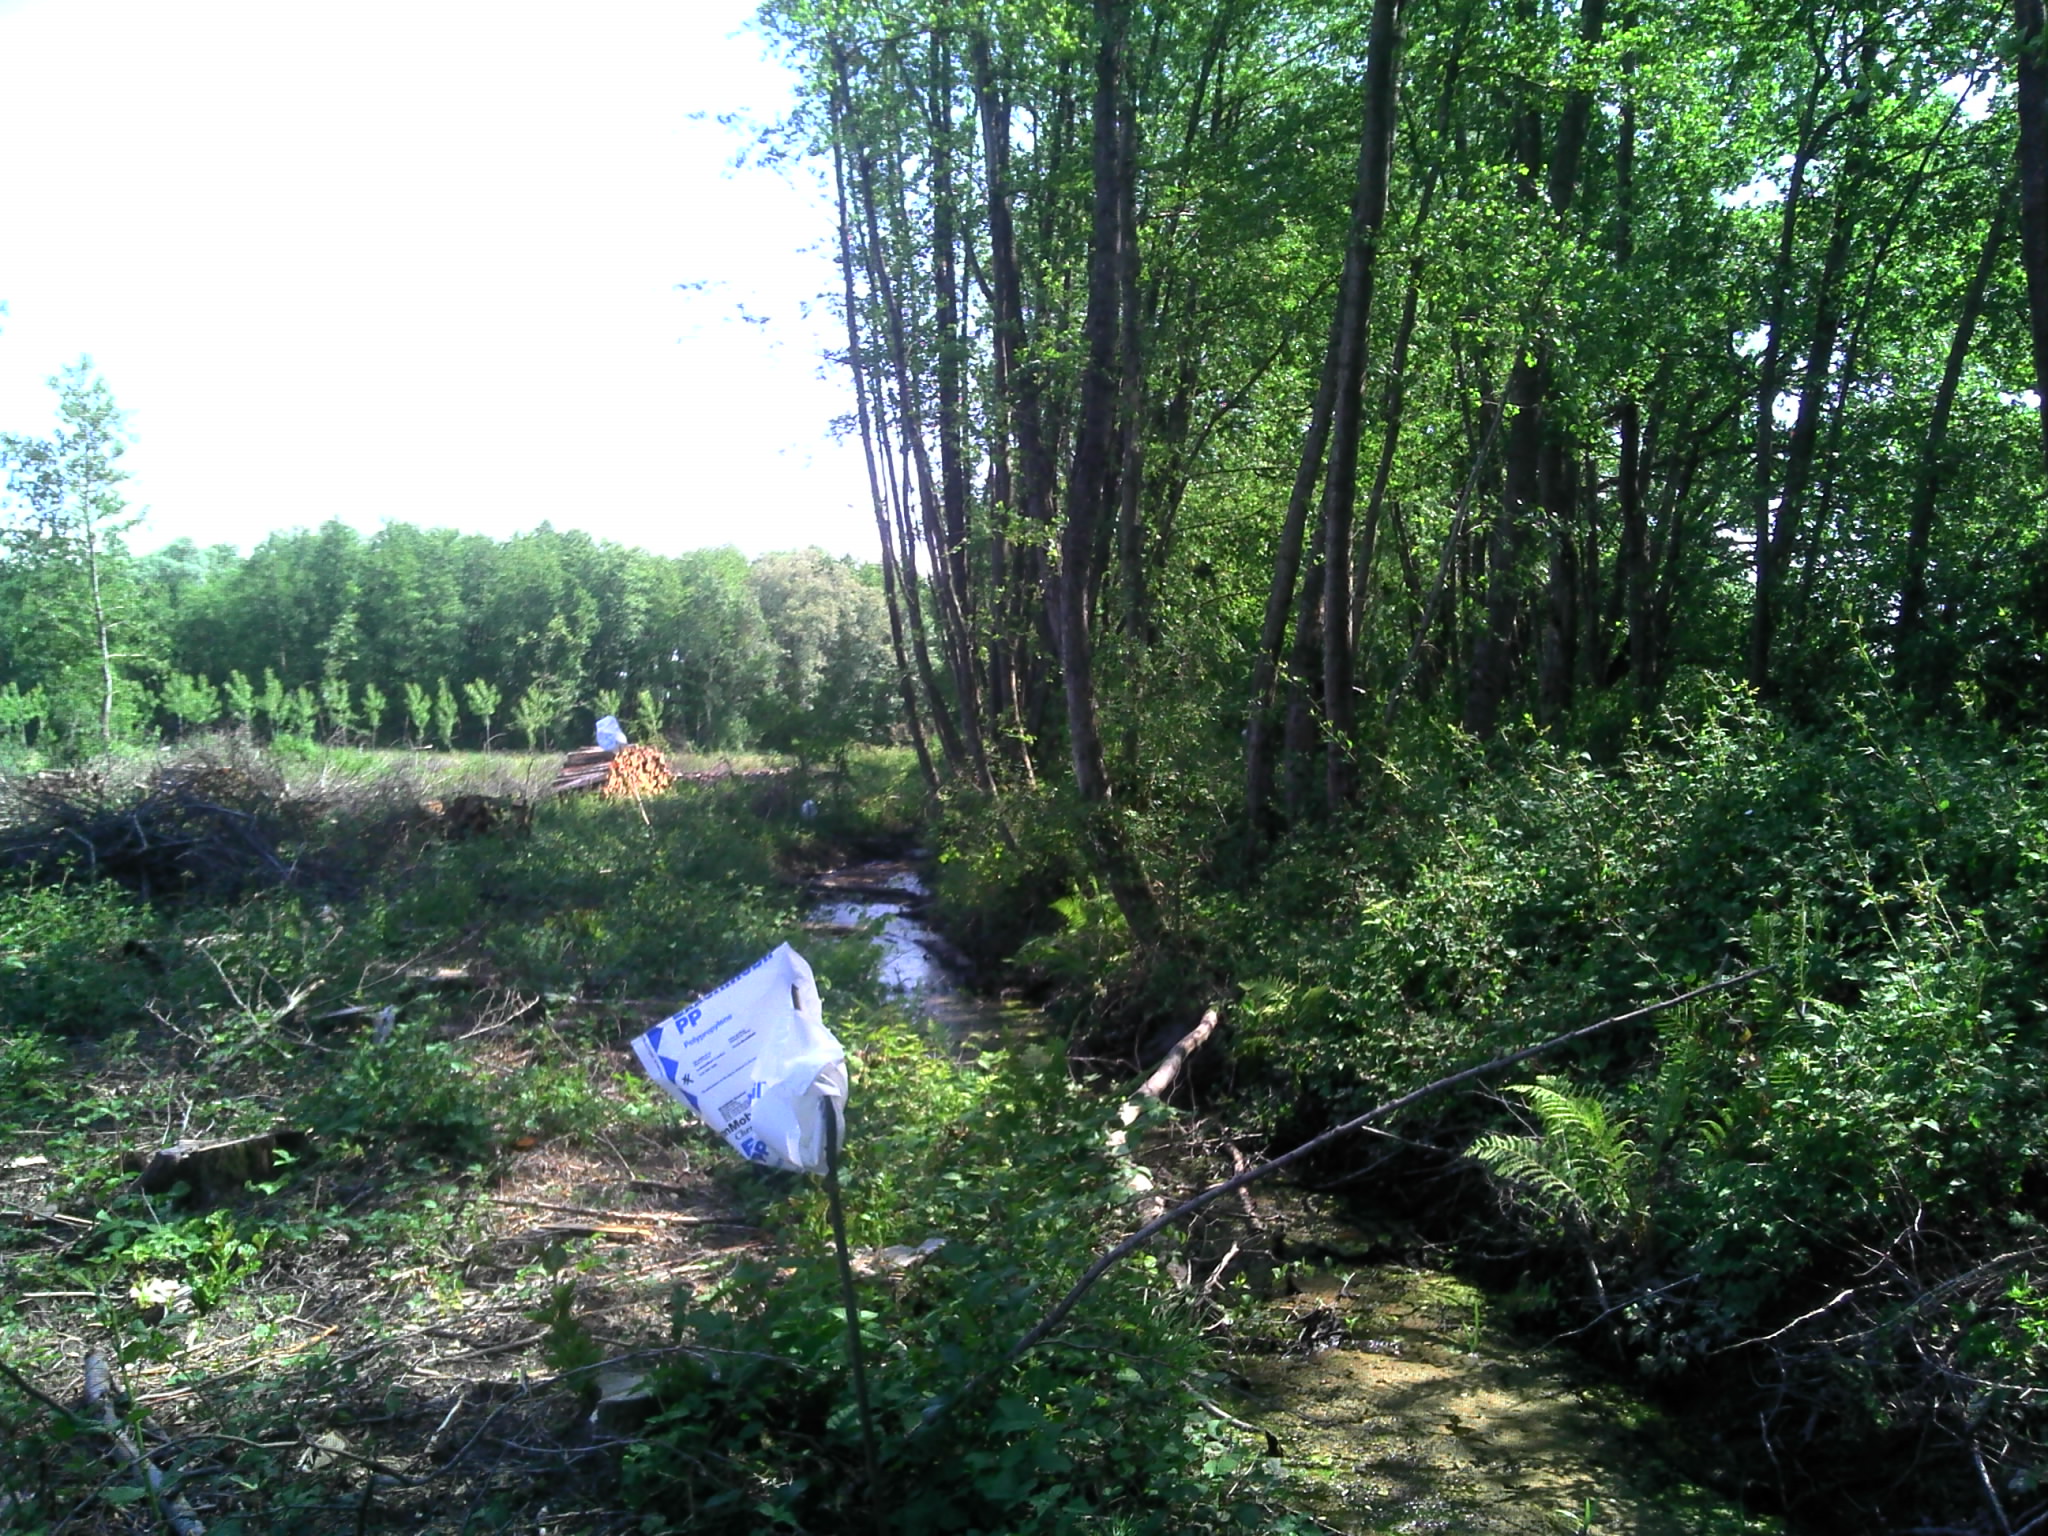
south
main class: Shrubland
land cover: Shrubland with sparse tree cover
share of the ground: 50 - 75 %
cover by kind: shrubs 60 %, herbaceous plants 20 %, consolidated bare surface 10 %, broadleaved forest trees 5 %, lichens and mosses 5 %
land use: Forestry
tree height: > 5 m
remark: Clear cut
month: May
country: FR
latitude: 46.5222
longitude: 4.9833
